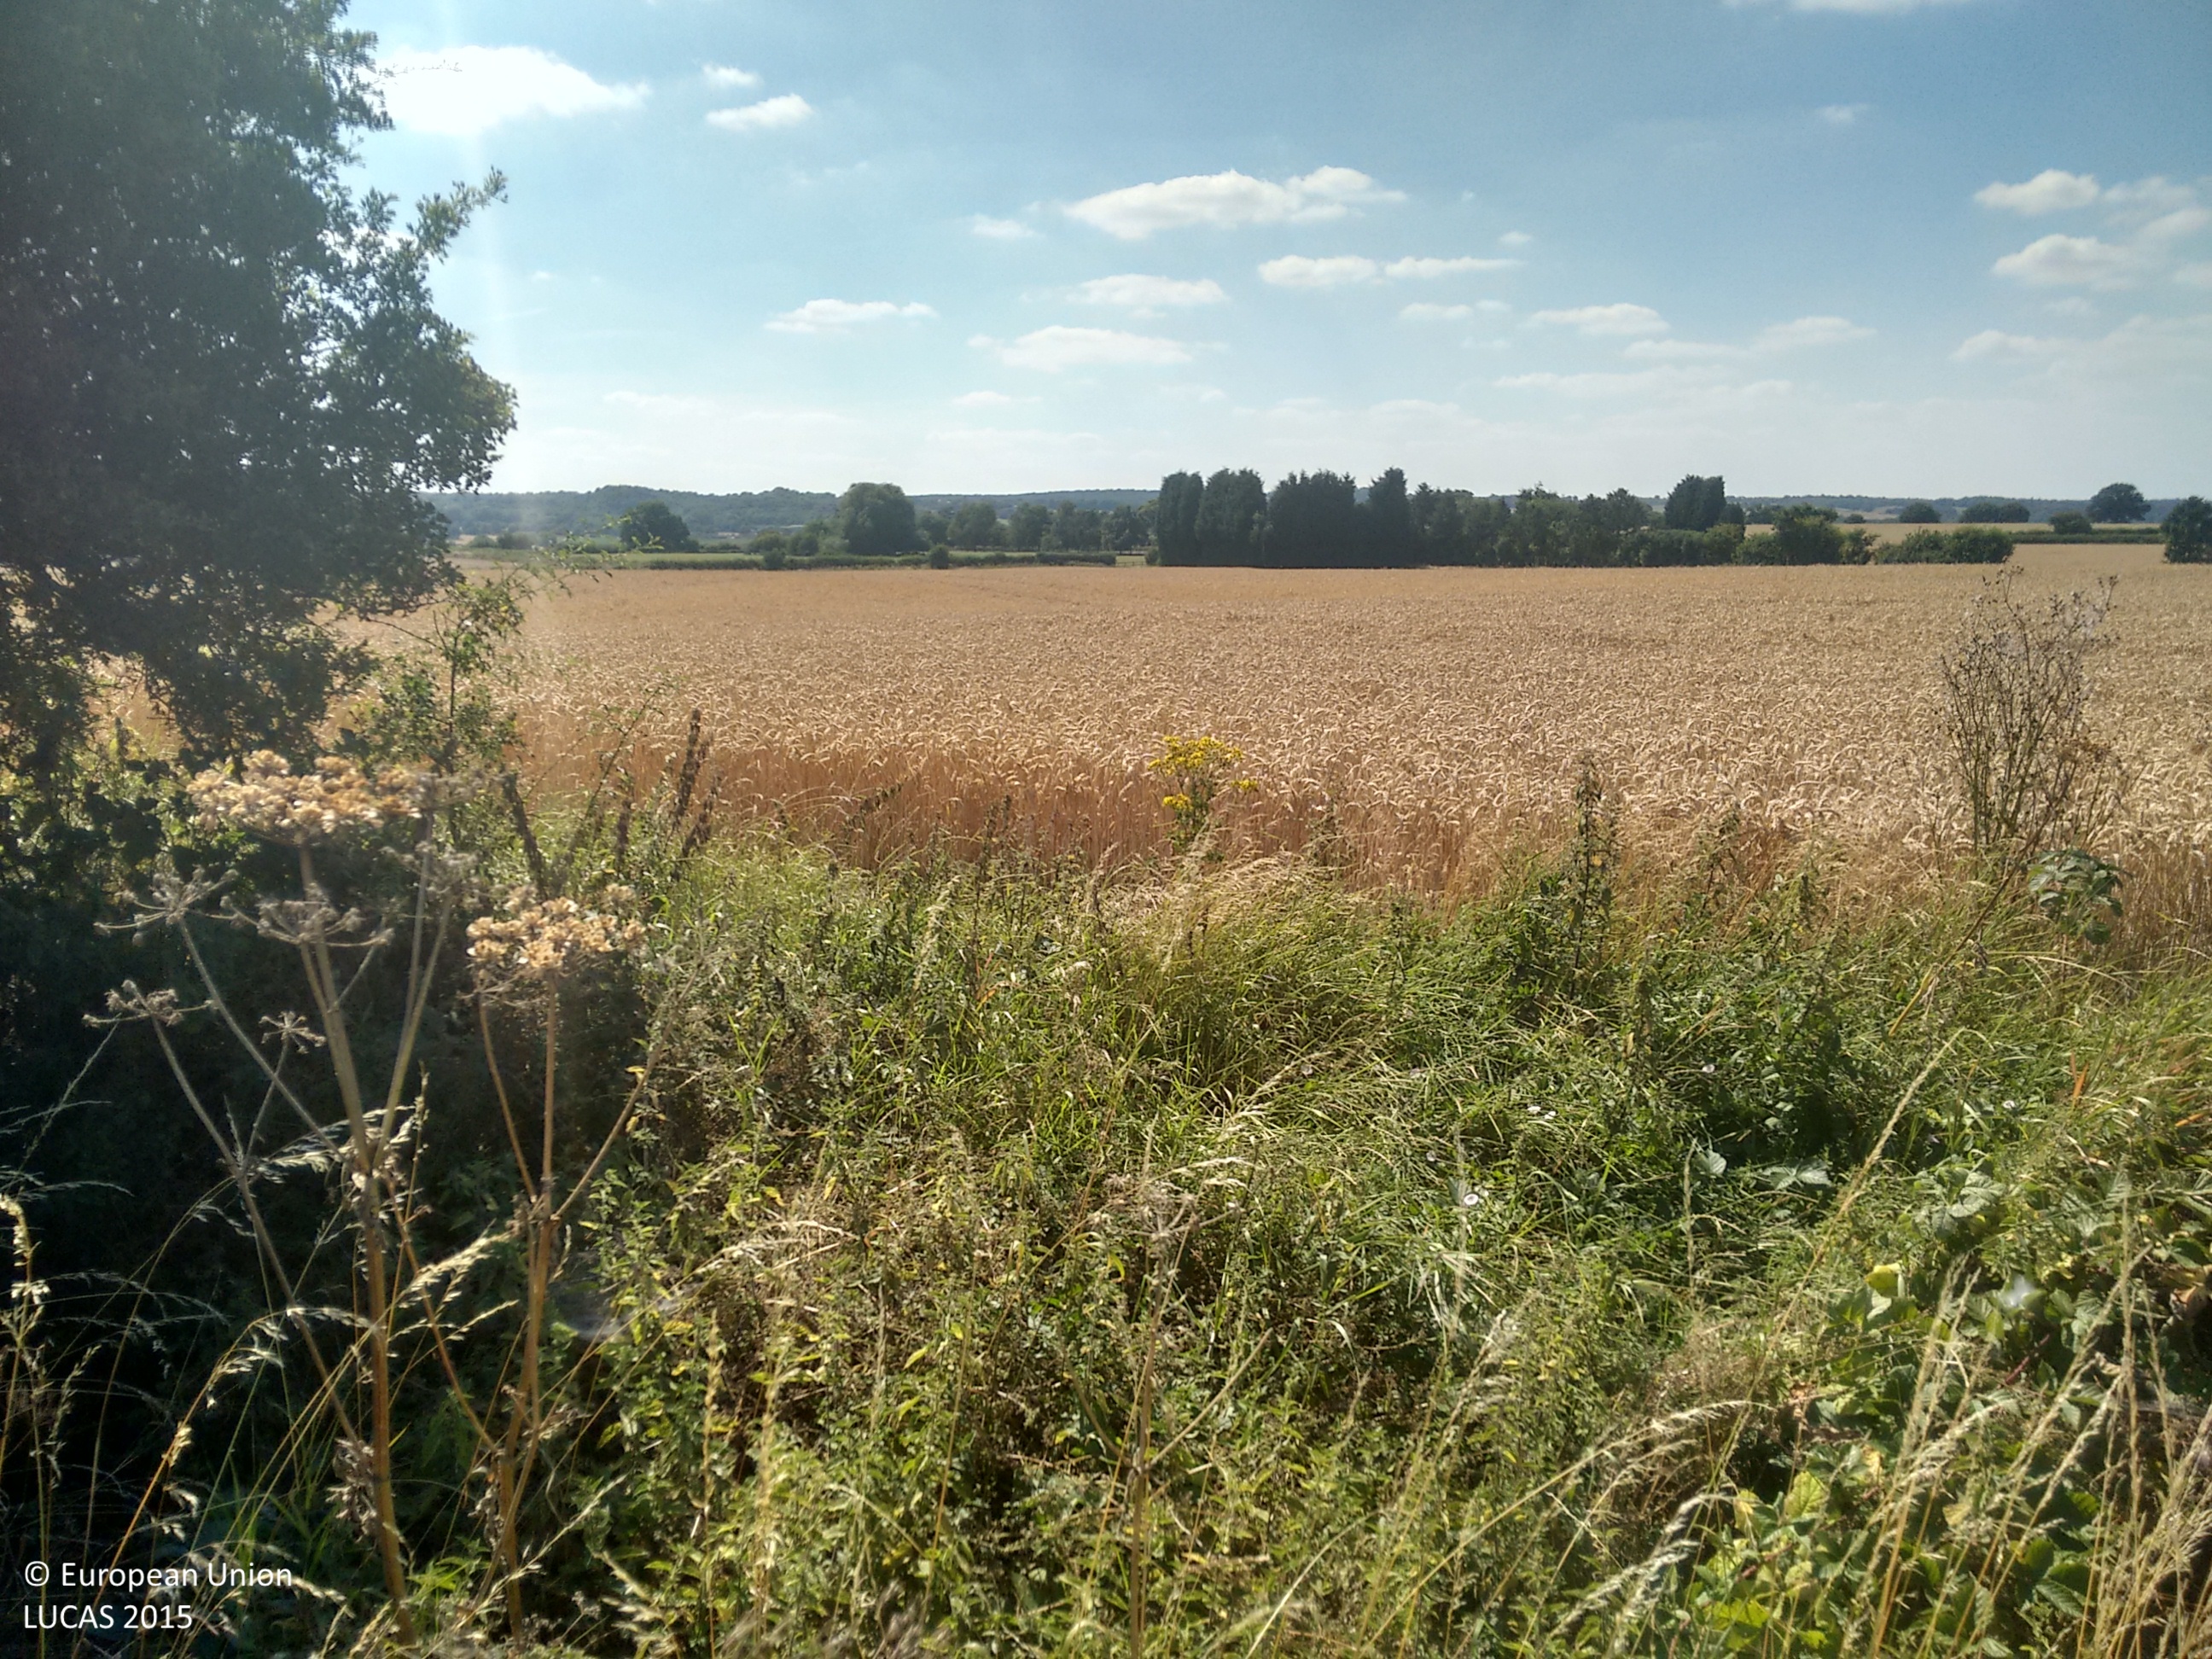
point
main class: Cropland
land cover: Common wheat
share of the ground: > 75 %
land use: Agriculture (excluding fallow land and kitchen gardens)
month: August
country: GB
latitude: 52.5629
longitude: -1.4834
